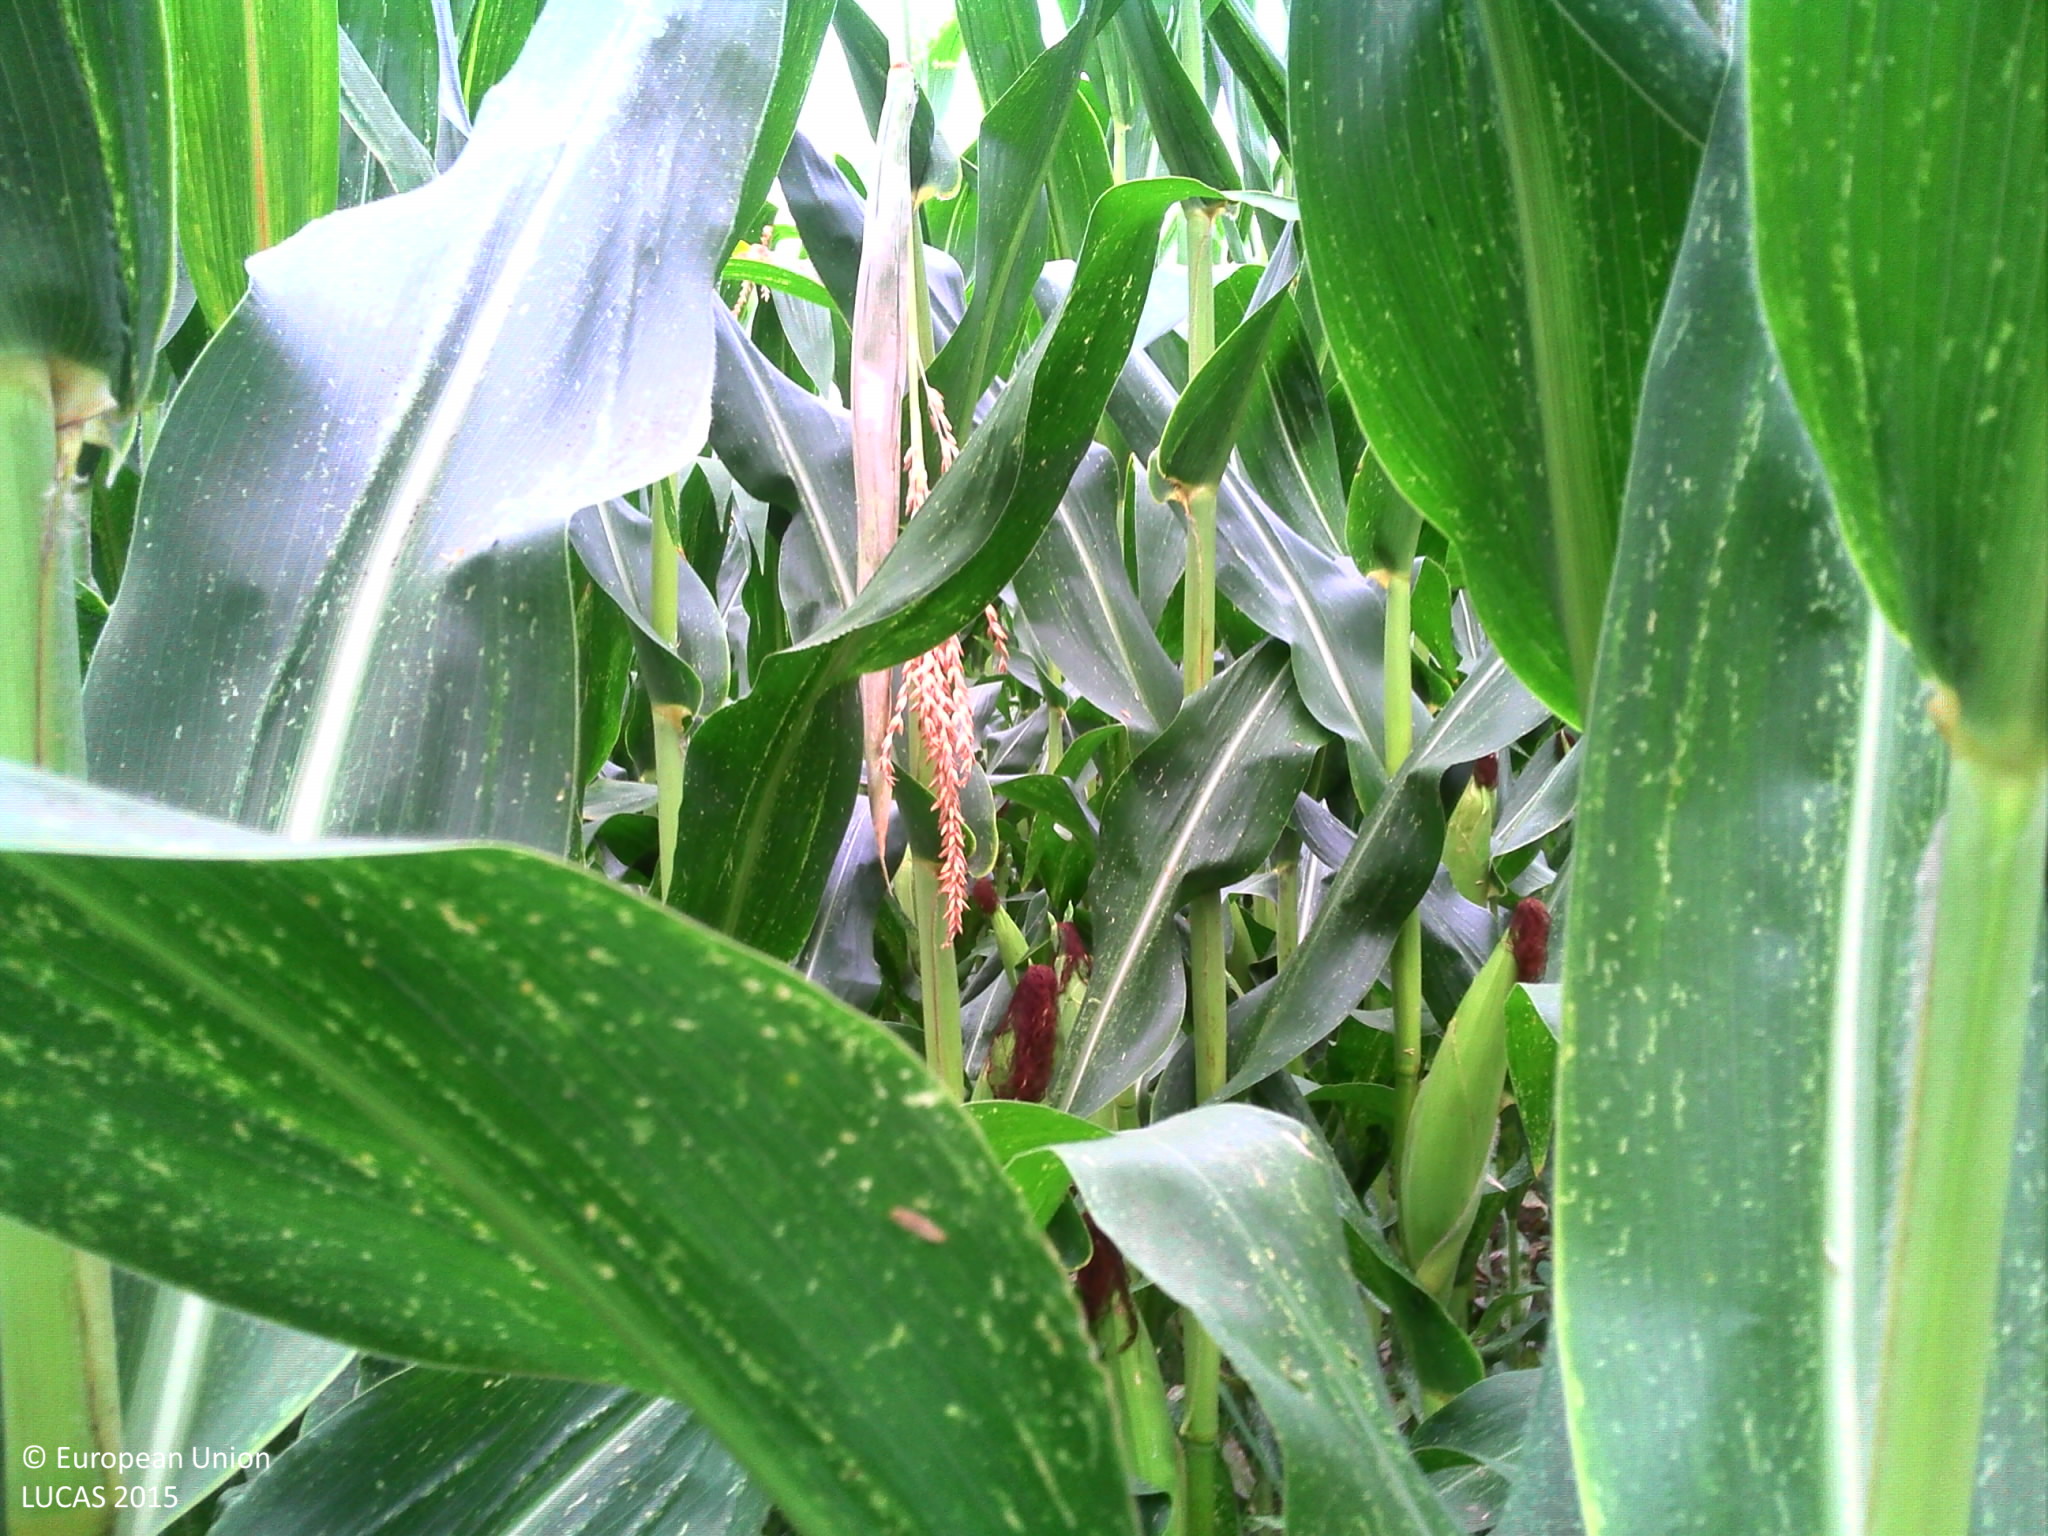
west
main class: Cropland
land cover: Maize
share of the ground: > 75 %
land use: Agriculture (excluding fallow land and kitchen gardens)
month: July
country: FR
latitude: 44.3985
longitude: 0.6401
